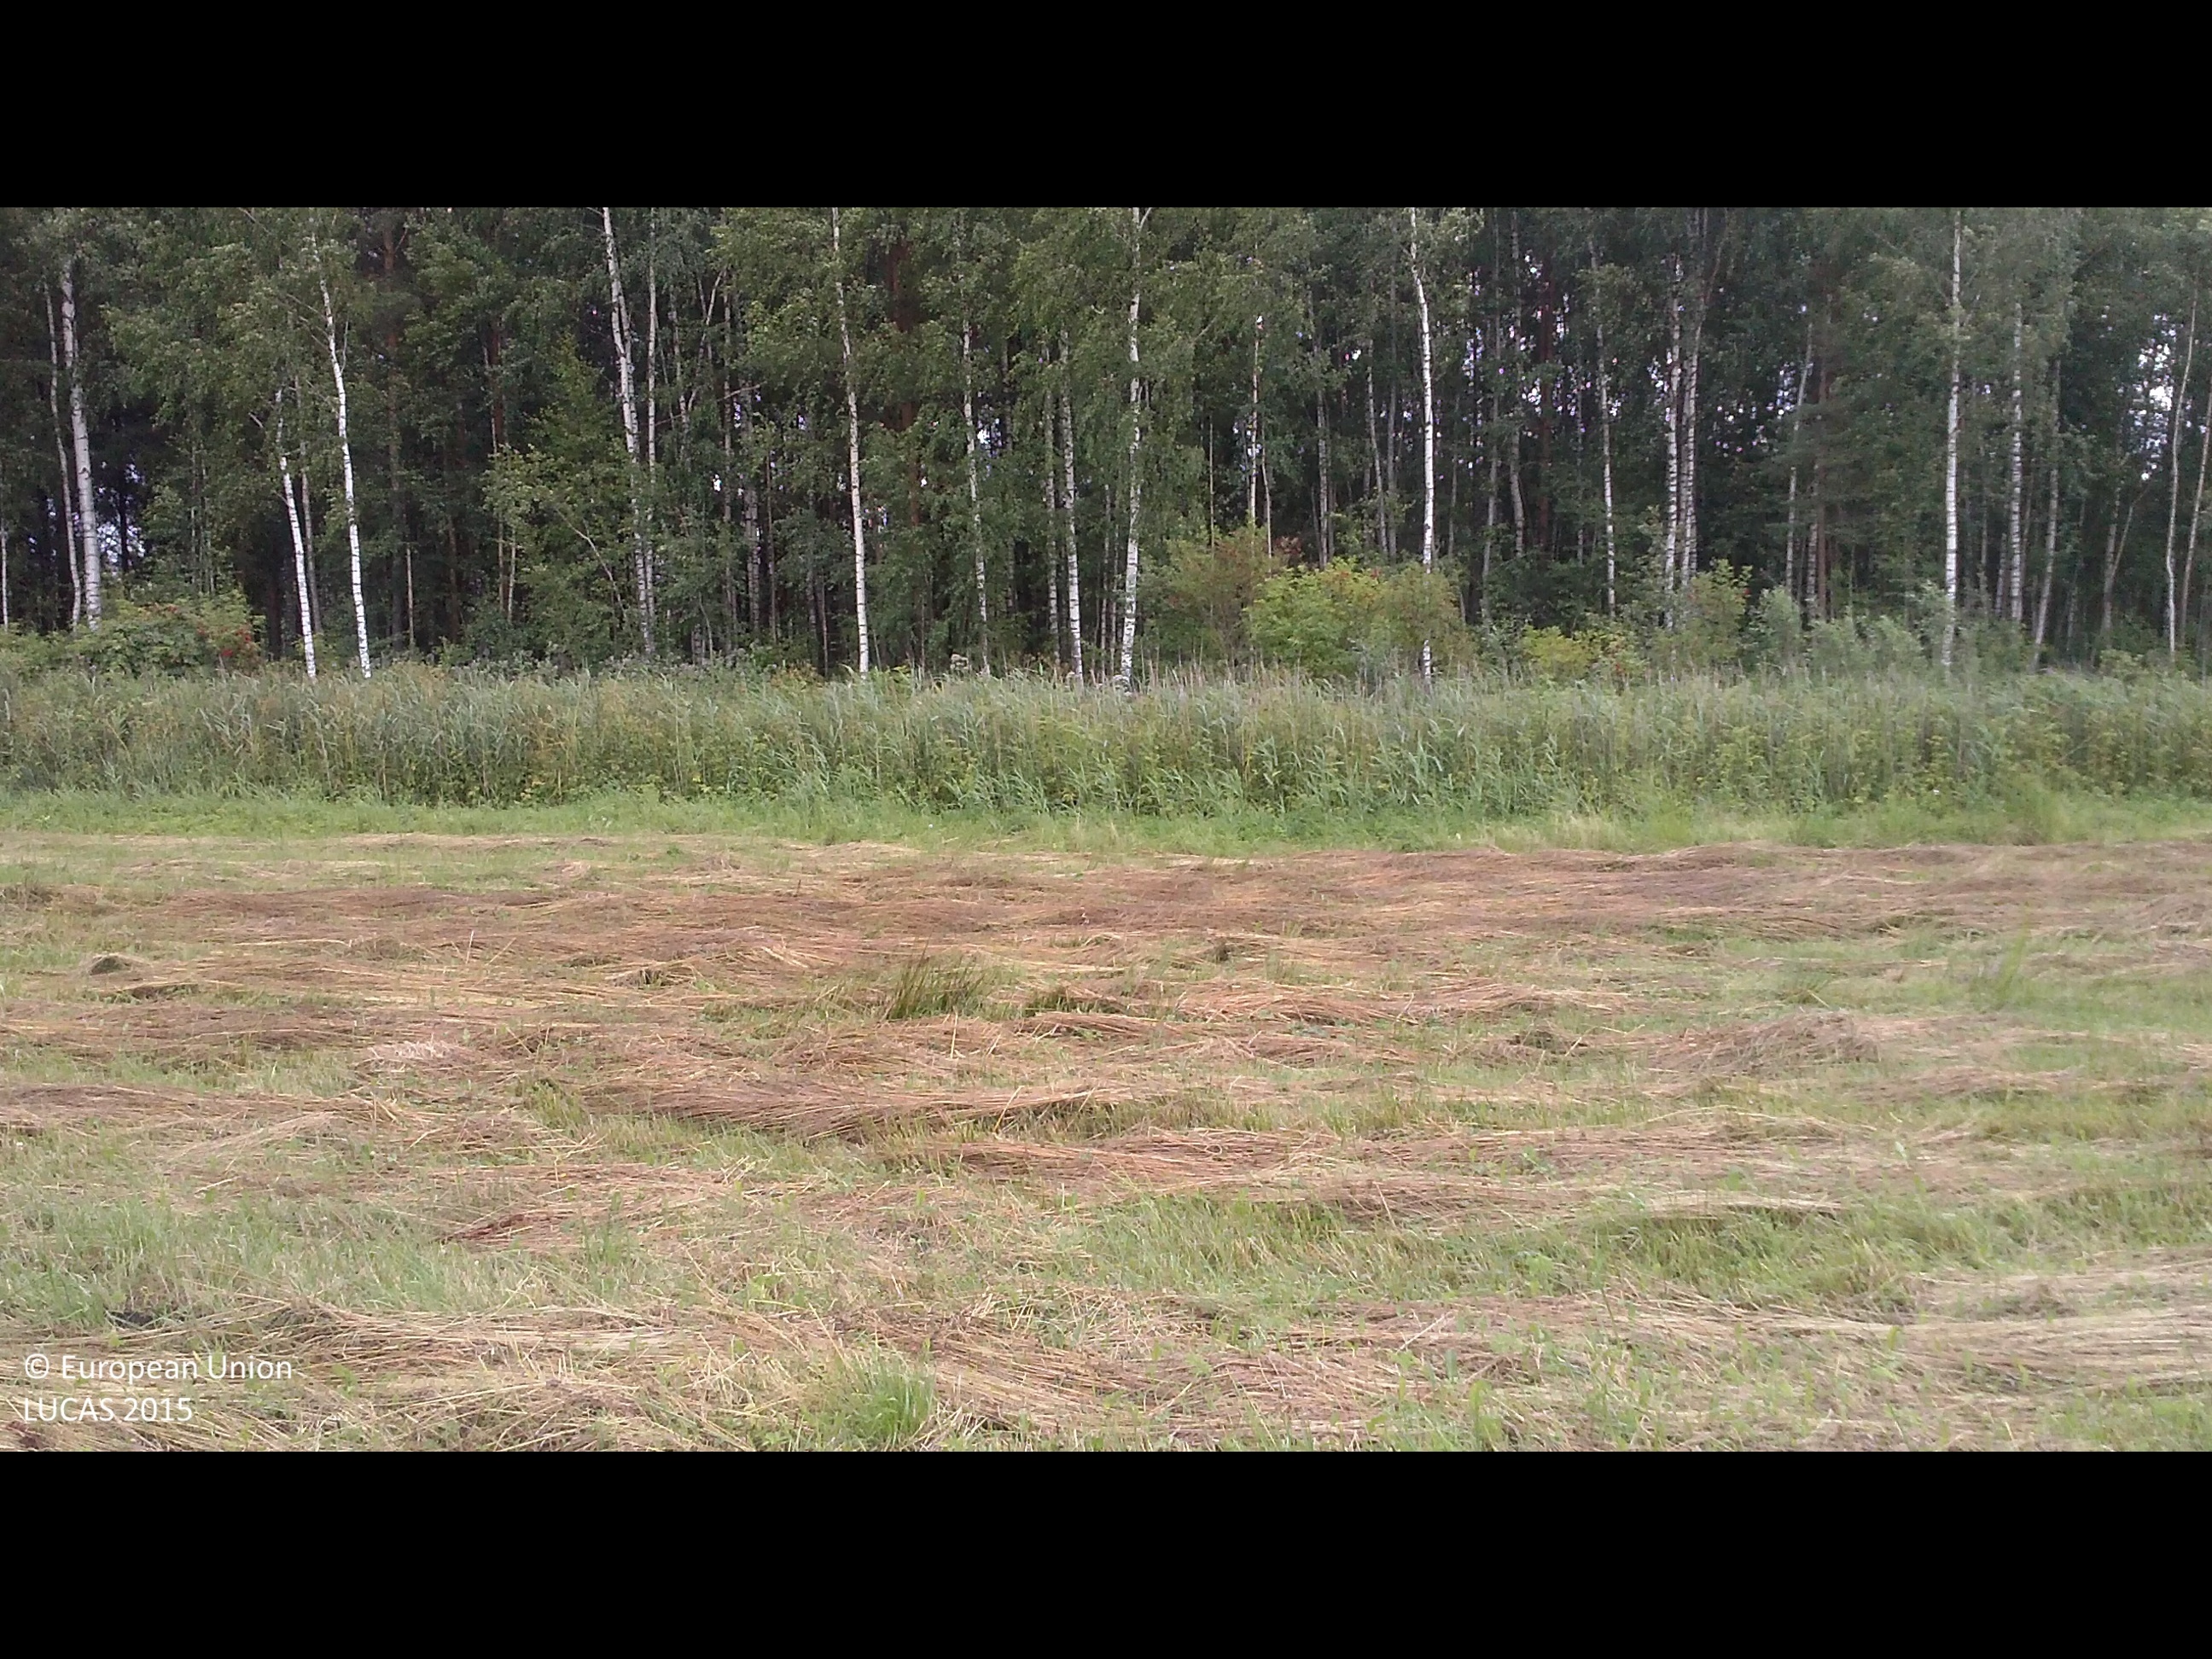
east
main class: Grassland
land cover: Grassland without tree/shrub cover
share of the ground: > 75 %
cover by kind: herbaceous plants 95 %, unconsolidated bare surface 5 %
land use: Agriculture (excluding fallow land and kitchen gardens)
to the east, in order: Grassland without tree/shrub cover; Spontaneously vegetated surfaces; Ditches and canals; Spontaneously vegetated surfaces; Broadleaved woodland; Pine dominated mixed woodland; Broadleaved woodland
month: July
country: LV
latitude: 56.4781
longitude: 26.9999
